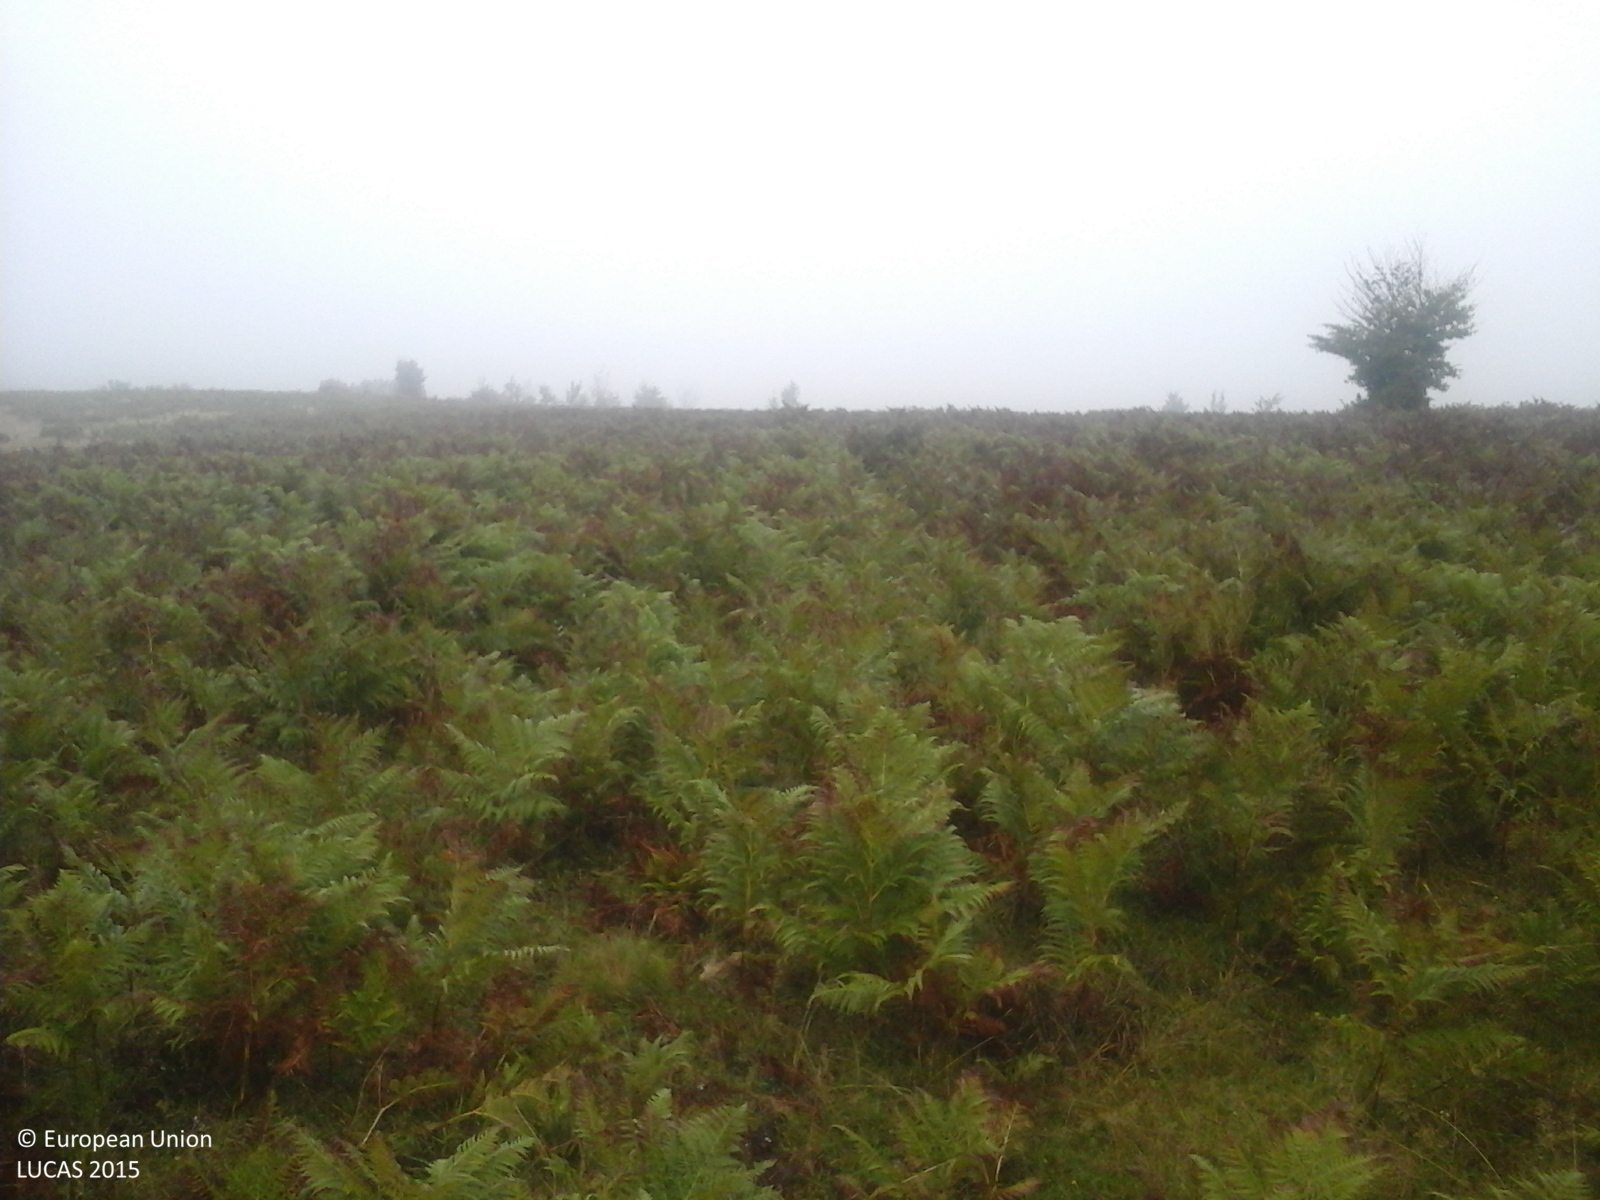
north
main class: Grassland
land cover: Spontaneously vegetated surfaces
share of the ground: > 75 %
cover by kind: herbaceous plants 100 %
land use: Agriculture (excluding fallow land and kitchen gardens)
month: September
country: RO
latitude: 46.9833
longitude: 22.4778
